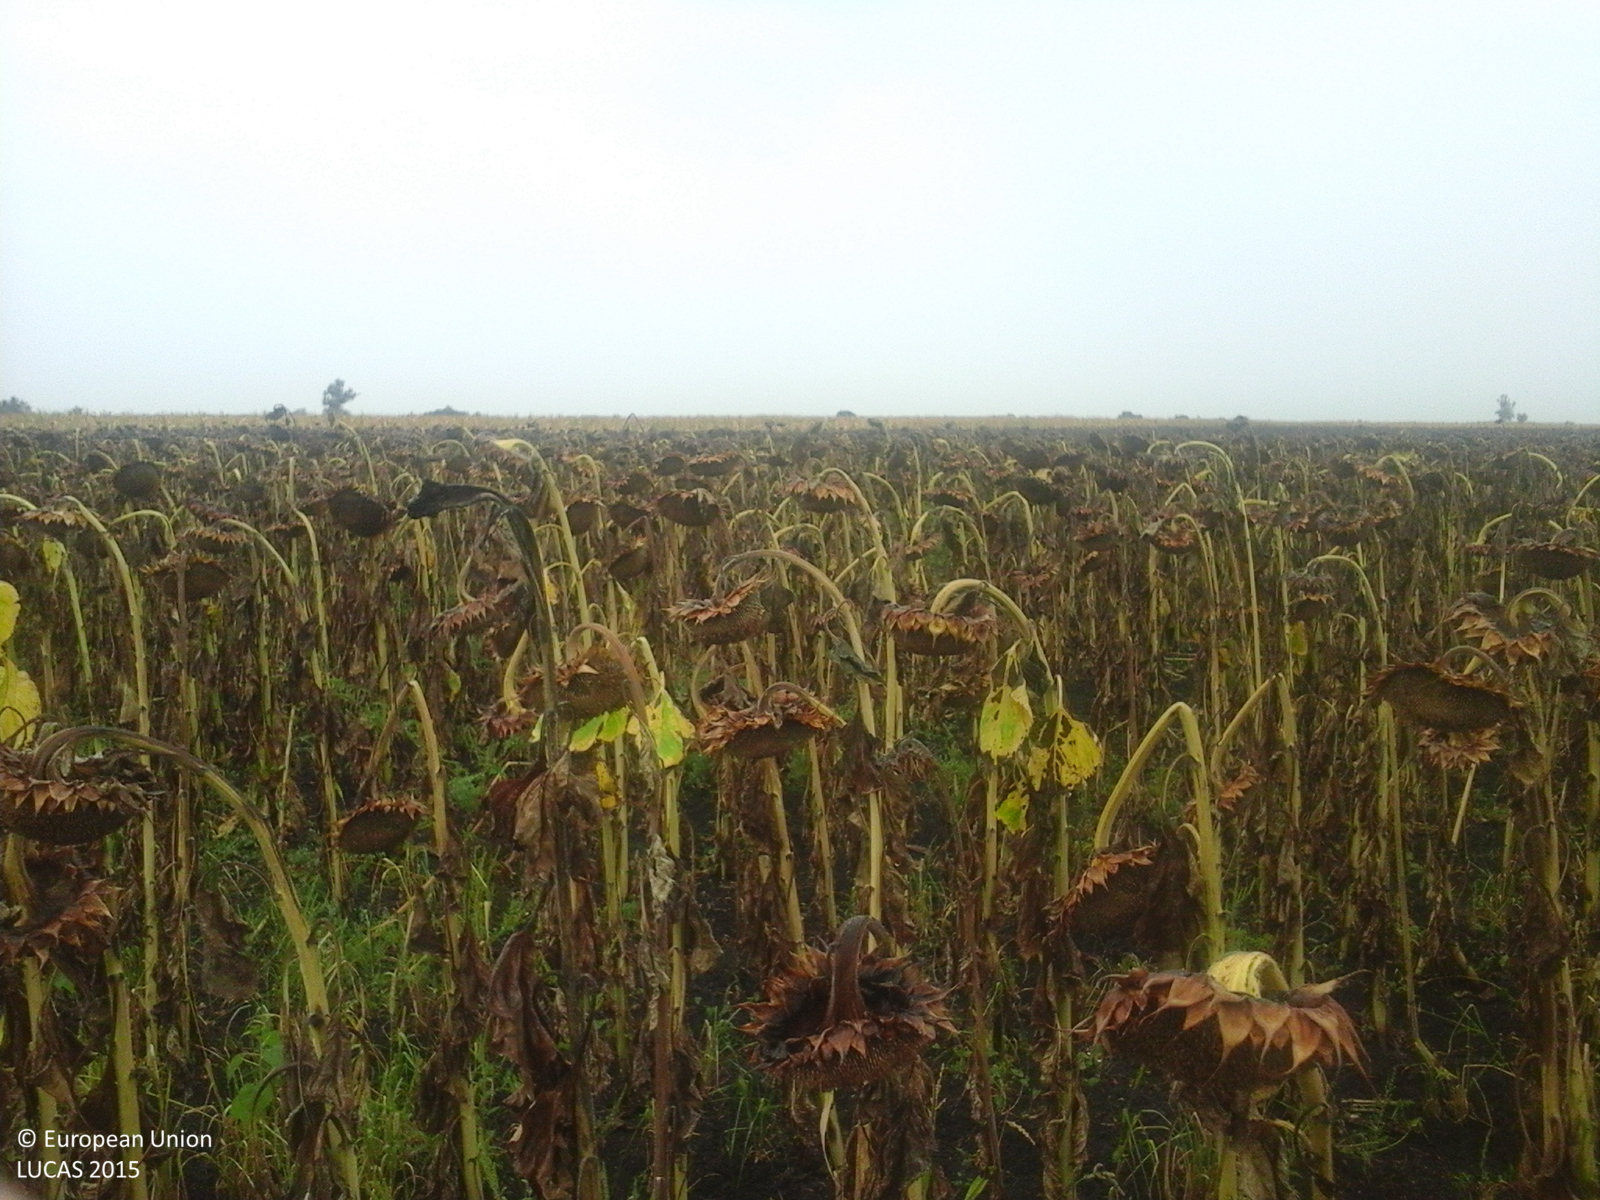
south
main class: Cropland
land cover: Sunflower
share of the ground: > 75 %
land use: Agriculture (excluding fallow land and kitchen gardens)
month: September
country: RO
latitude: 47.7392
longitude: 22.5547
